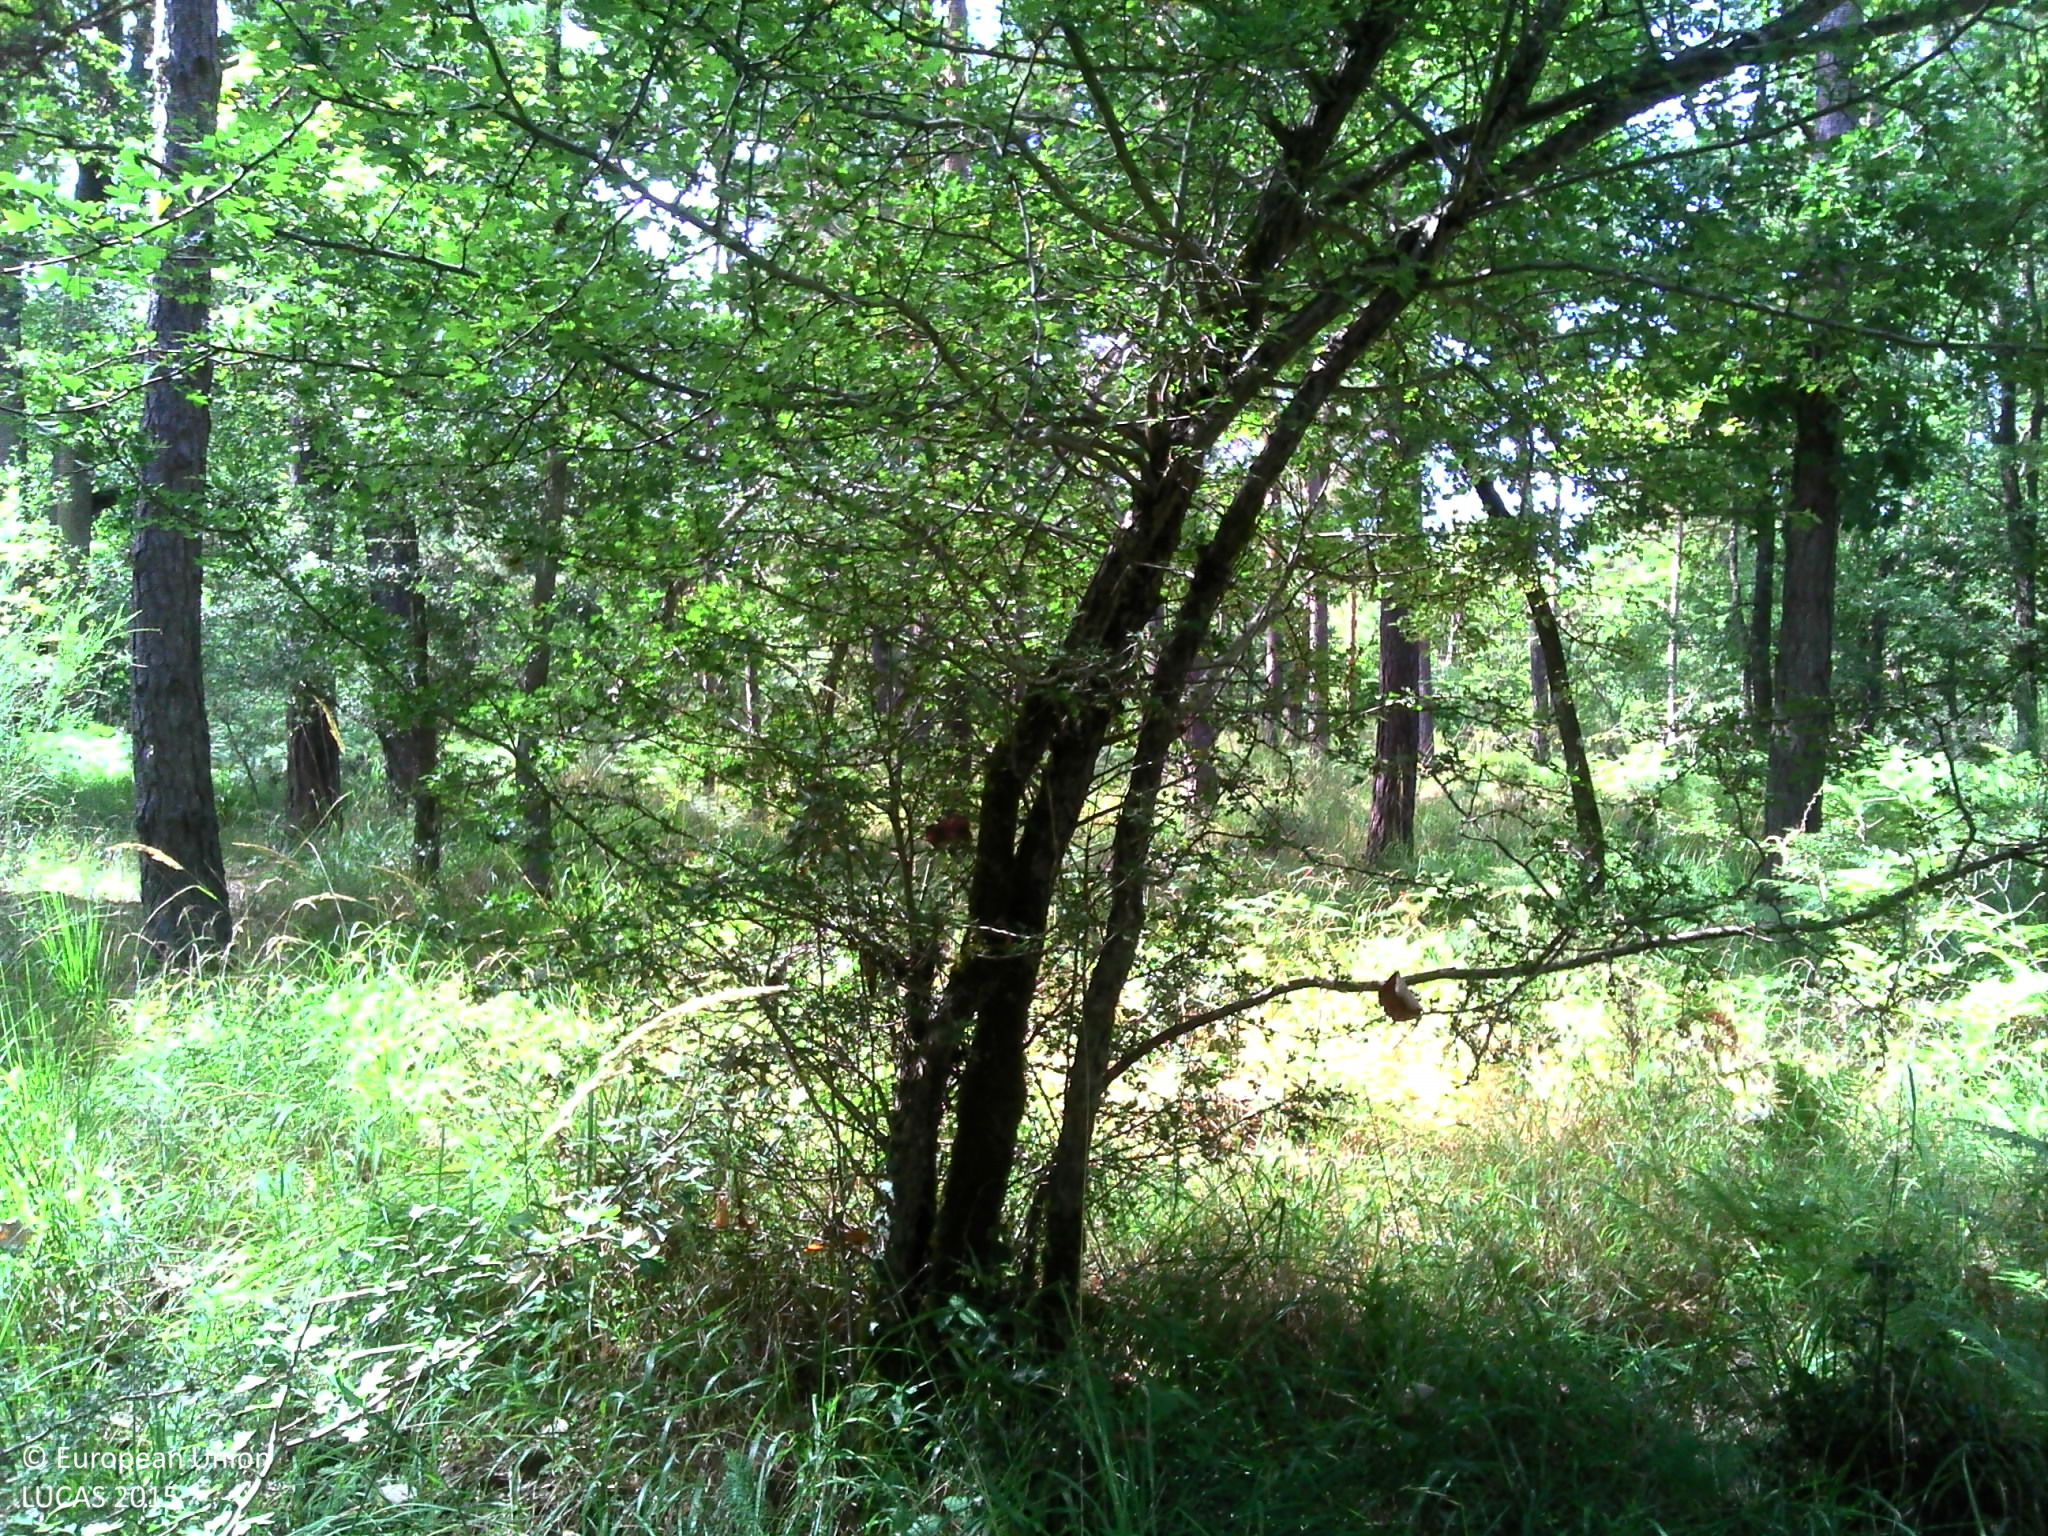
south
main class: Woodland
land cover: Pine dominated mixed woodland
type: hemiboreal forest and nemoral coniferous forest and mixed broadleaved-coniferous forest
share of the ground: > 75 %
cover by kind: herbaceous plants 45 %, broadleaved forest trees 30 %, coniferous forest trees 25 %
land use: Forestry
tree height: > 5 m
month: August
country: FR
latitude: 48.3797
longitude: 2.7132
